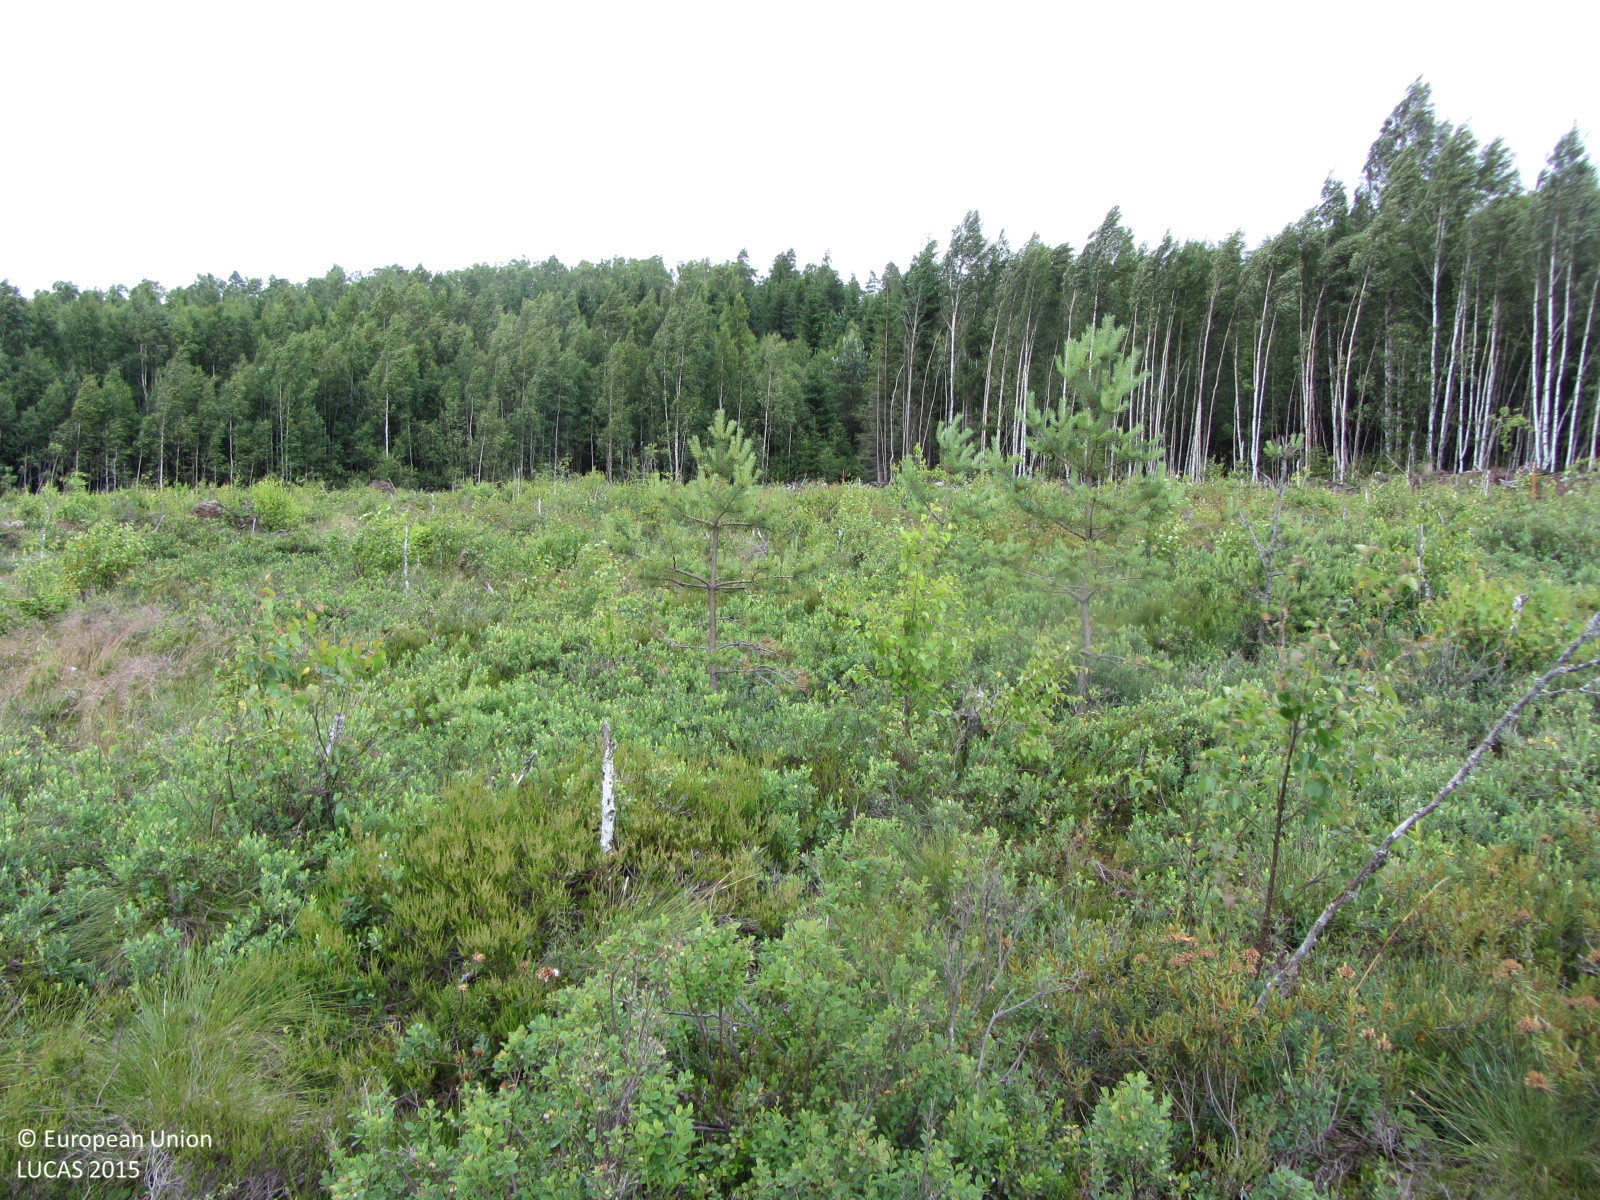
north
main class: Woodland
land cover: Broadleaved woodland
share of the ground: 25 - 50 %
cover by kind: shrubs 50 %, broadleaved forest trees 40 %, coniferous forest trees 5 %, herbaceous plants 5 %
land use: Forestry
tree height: < 5 m
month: July
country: FI
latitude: 60.0338
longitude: 23.9363
